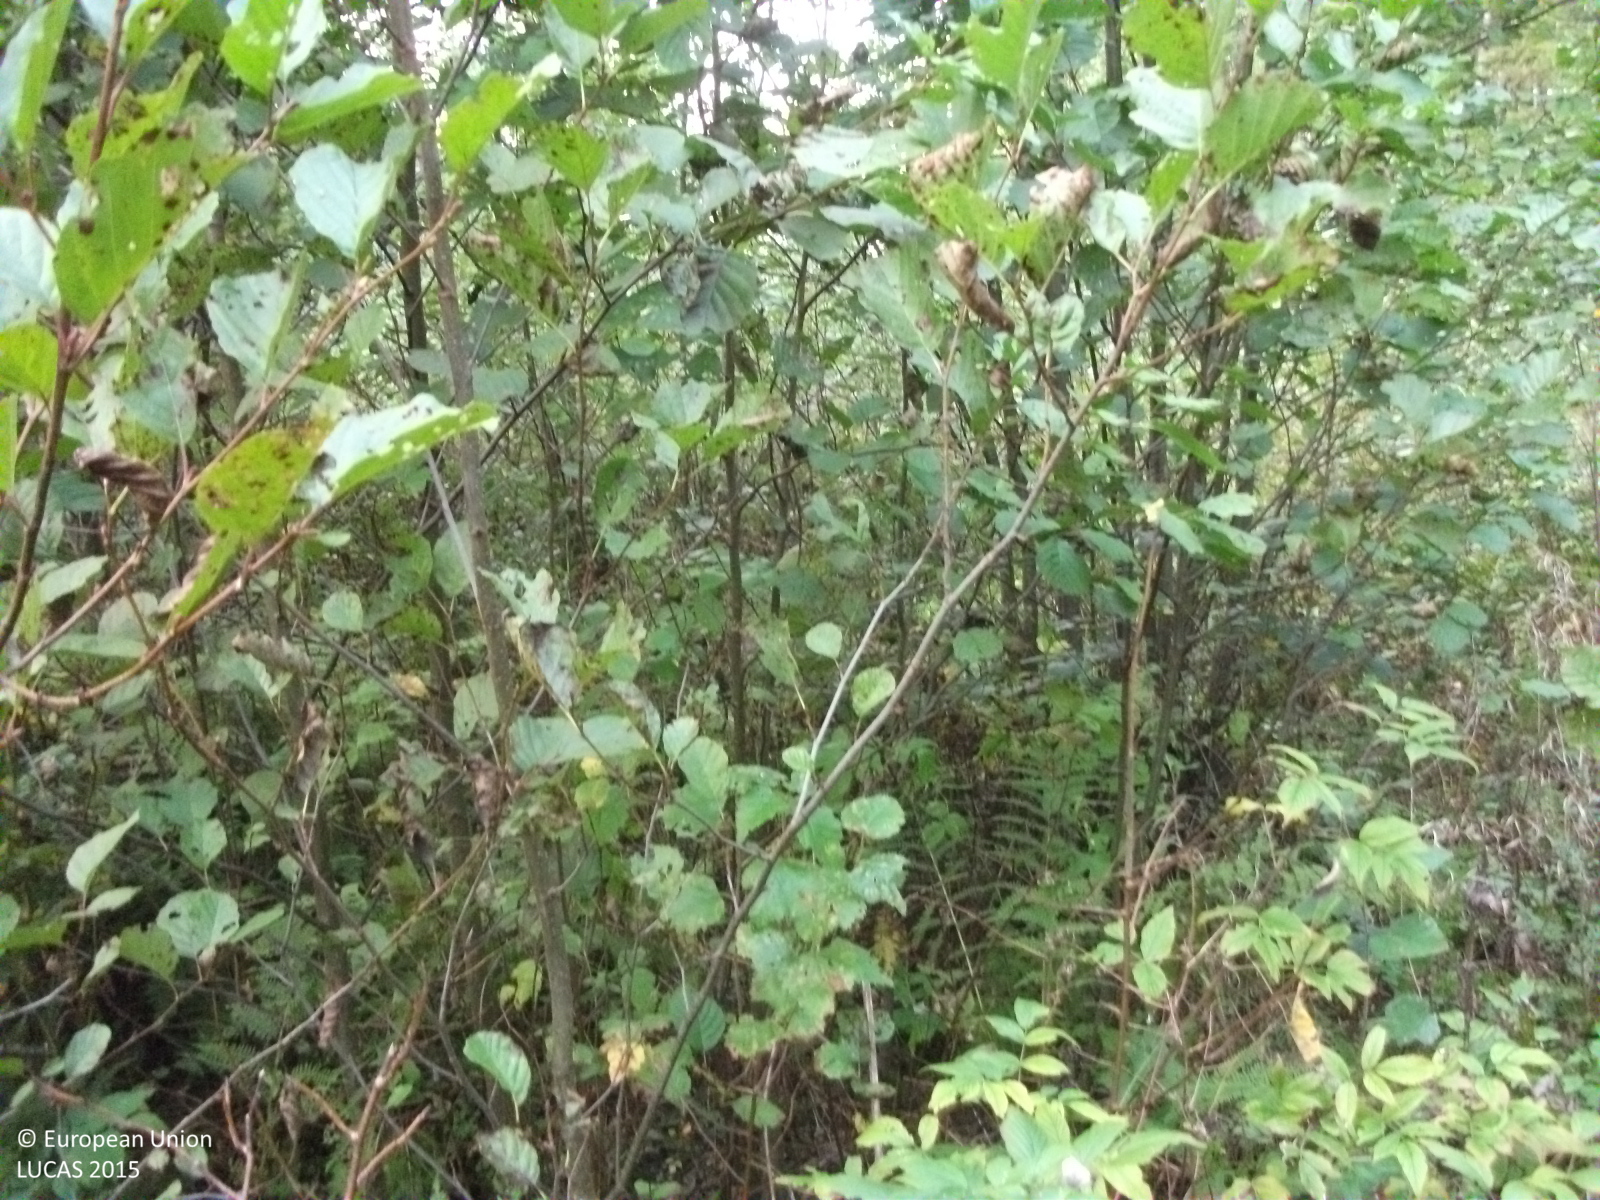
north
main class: Woodland
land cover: Broadleaved woodland
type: non-riverine alder, birch or aspen forest
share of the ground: 25 - 50 %
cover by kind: shrubs 50 %, broadleaved forest trees 40 %, herbaceous plants 10 %
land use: Forestry
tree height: < 5 m
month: September
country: LV
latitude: 57.8982
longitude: 24.5486
